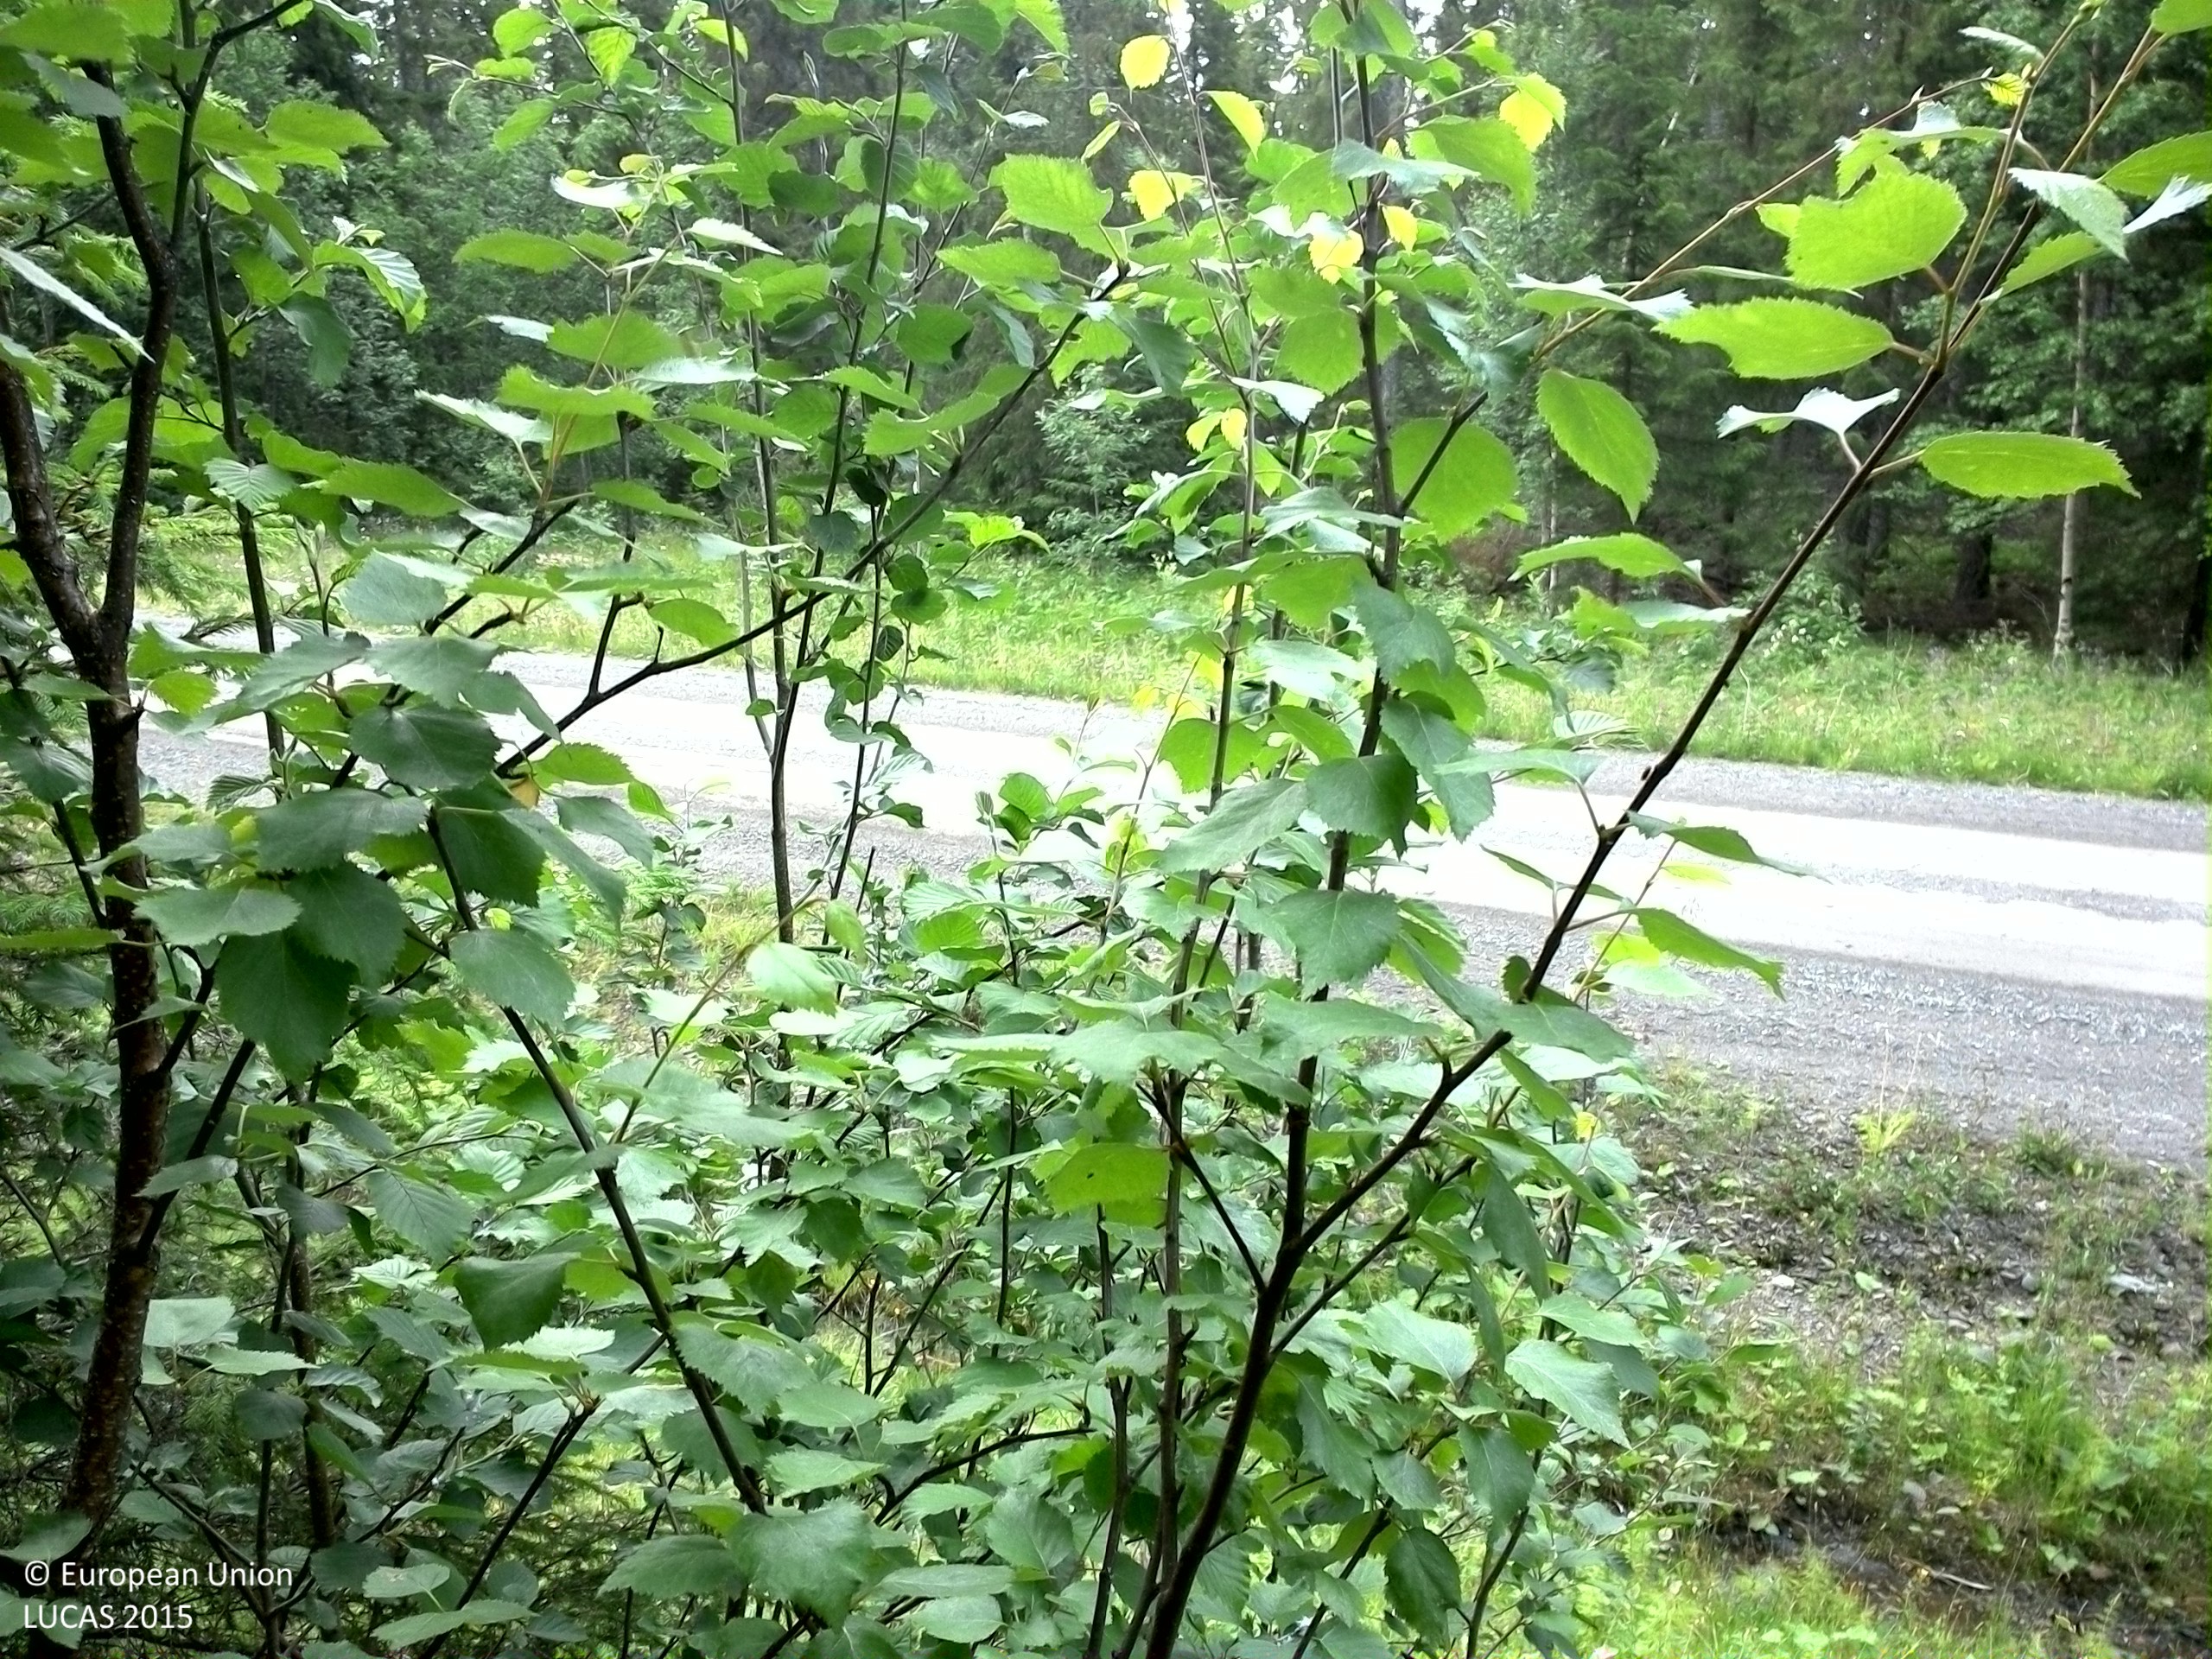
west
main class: Woodland
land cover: Spruce dominated coniferous woodland
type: boreal forest
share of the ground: 50 - 75 %
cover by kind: coniferous forest trees 60 %, shrubs 30 %, broadleaved forest trees 5 %, herbaceous plants 5 %
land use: Forestry
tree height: > 5 m
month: July
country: SE
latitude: 64.4127
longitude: 15.9668
